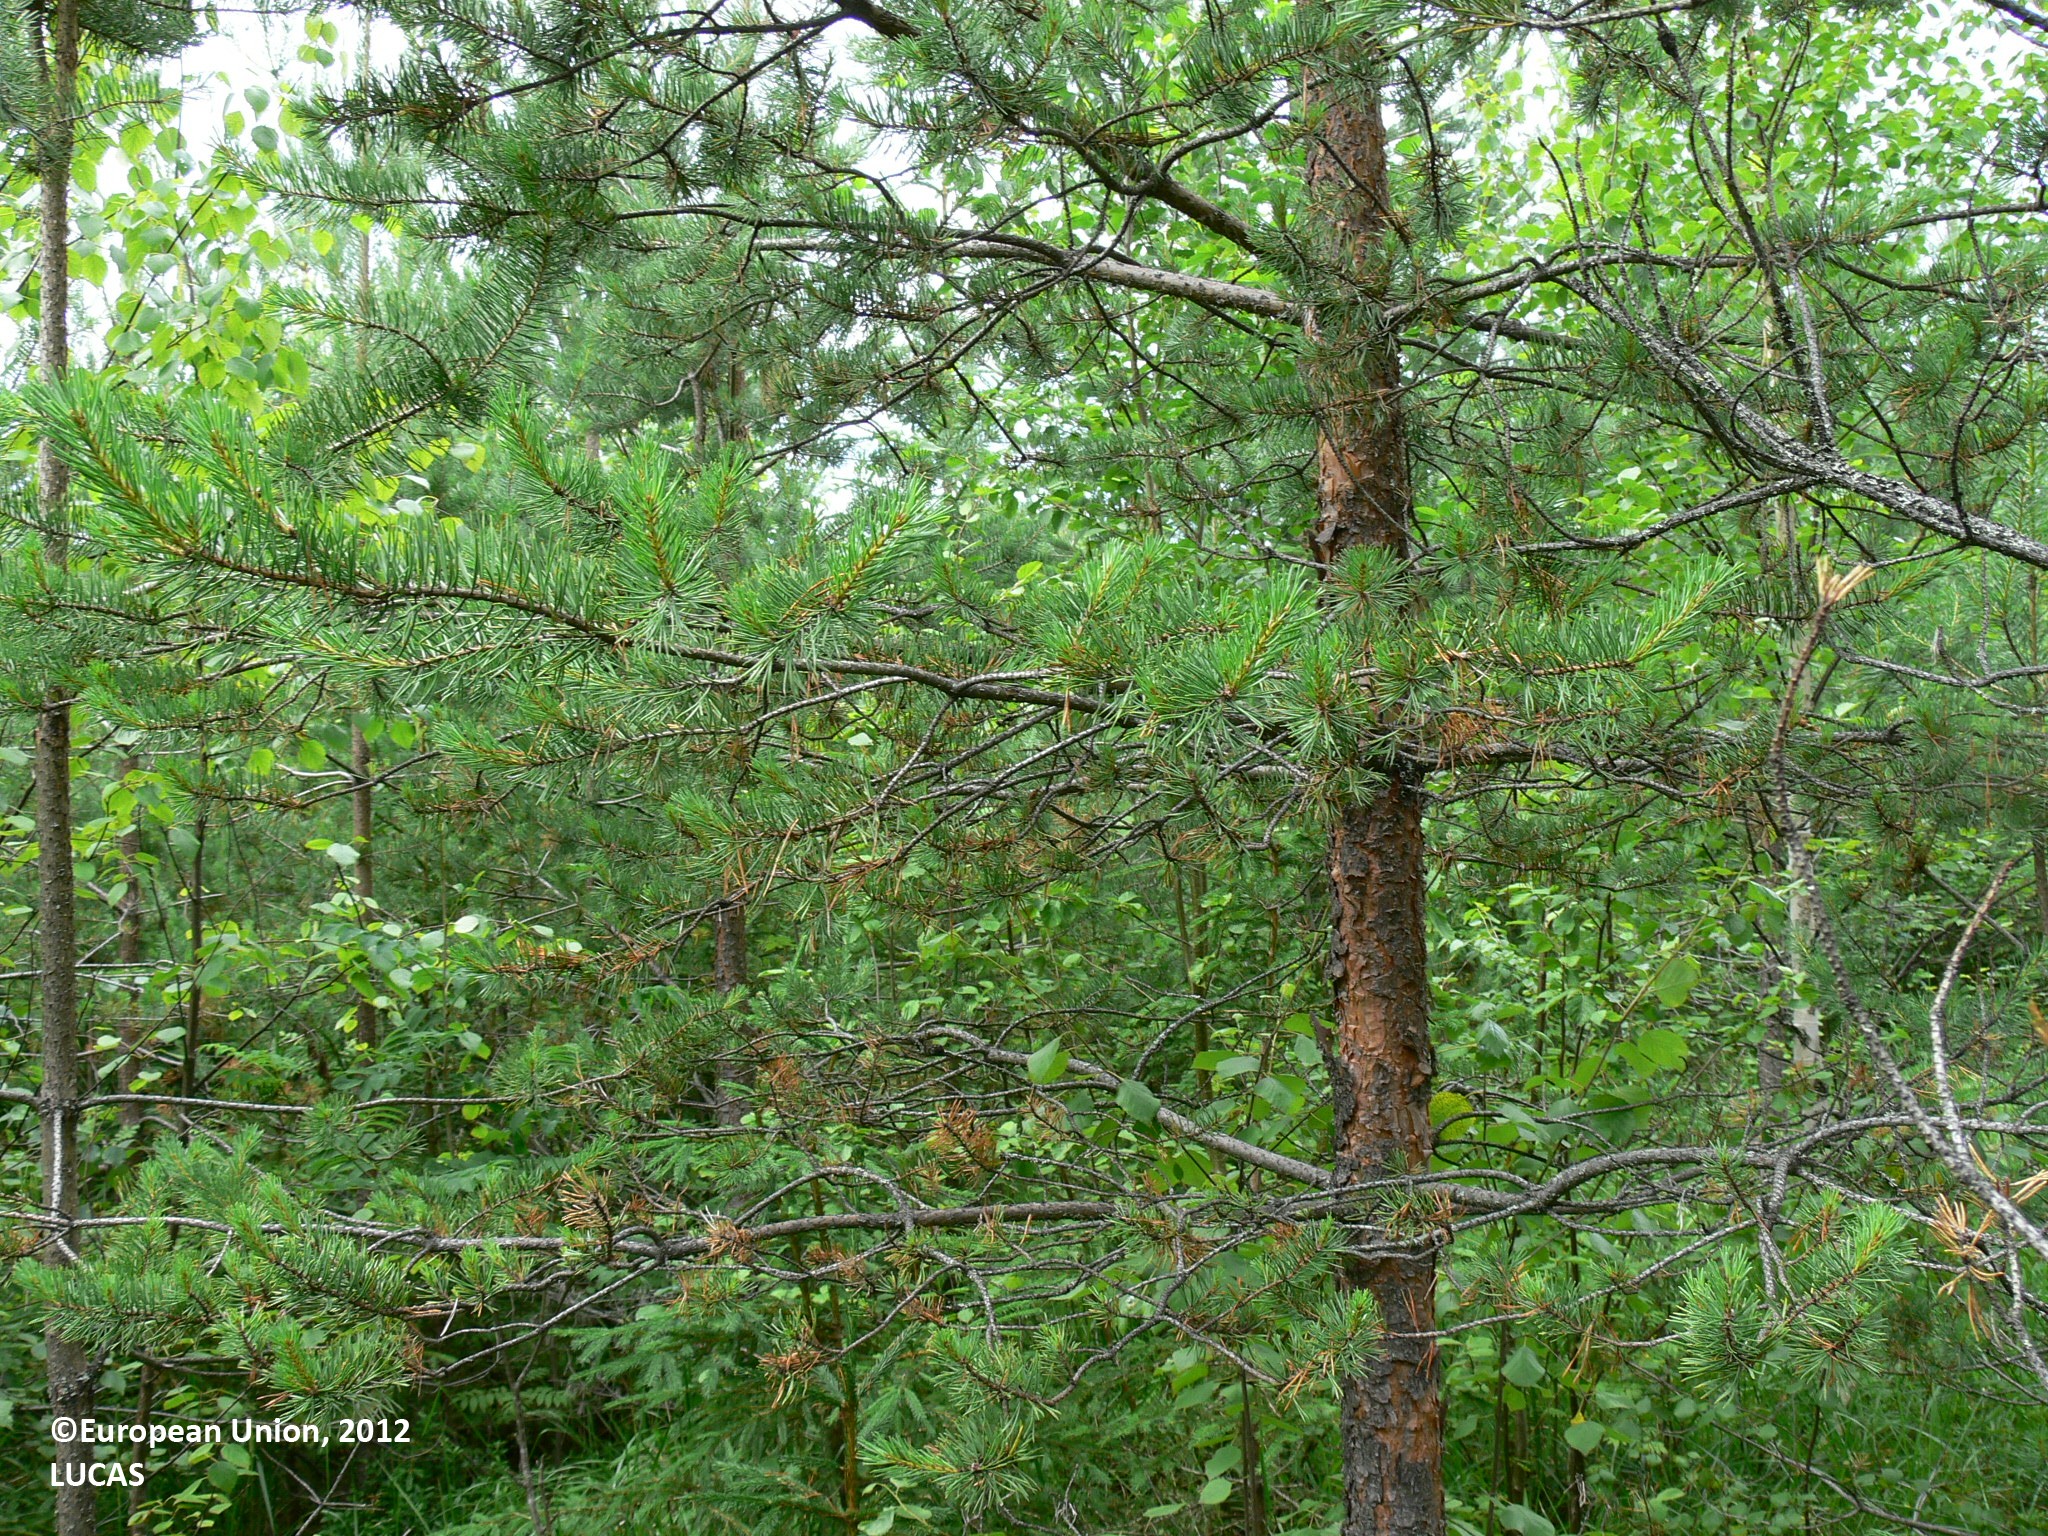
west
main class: Woodland
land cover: Pine dominated mixed woodland
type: boreal forest
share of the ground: > 75 %
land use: Forestry
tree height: > 5 m
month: July
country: FI
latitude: 63.0011
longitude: 29.4837
